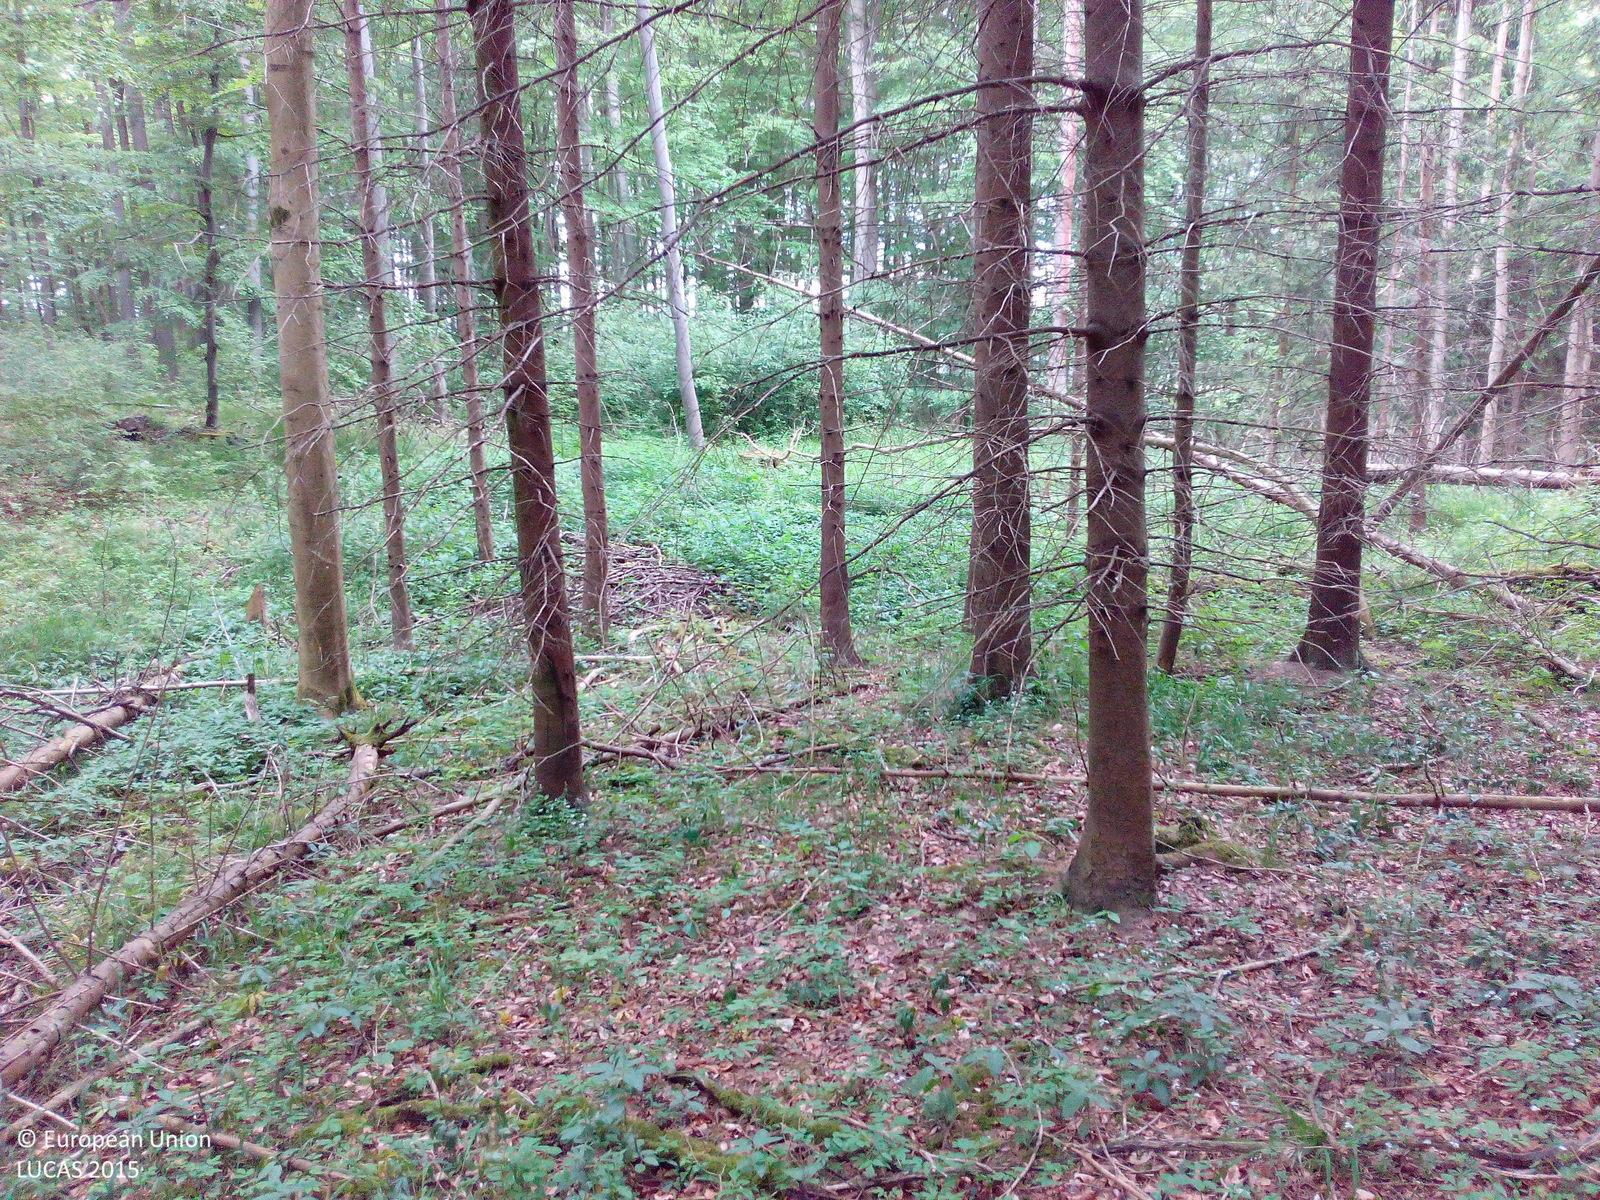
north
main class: Woodland
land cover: Spruce dominated coniferous woodland
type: hemiboreal forest and nemoral coniferous forest and mixed broadleaved-coniferous forest
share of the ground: > 75 %
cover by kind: coniferous forest trees 80 %, broadleaved forest trees 15 %, shrubs 5 %
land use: Forestry
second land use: Amenities, museums, leisure
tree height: > 5 m
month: May
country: DE
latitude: 51.9820
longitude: 9.8981
